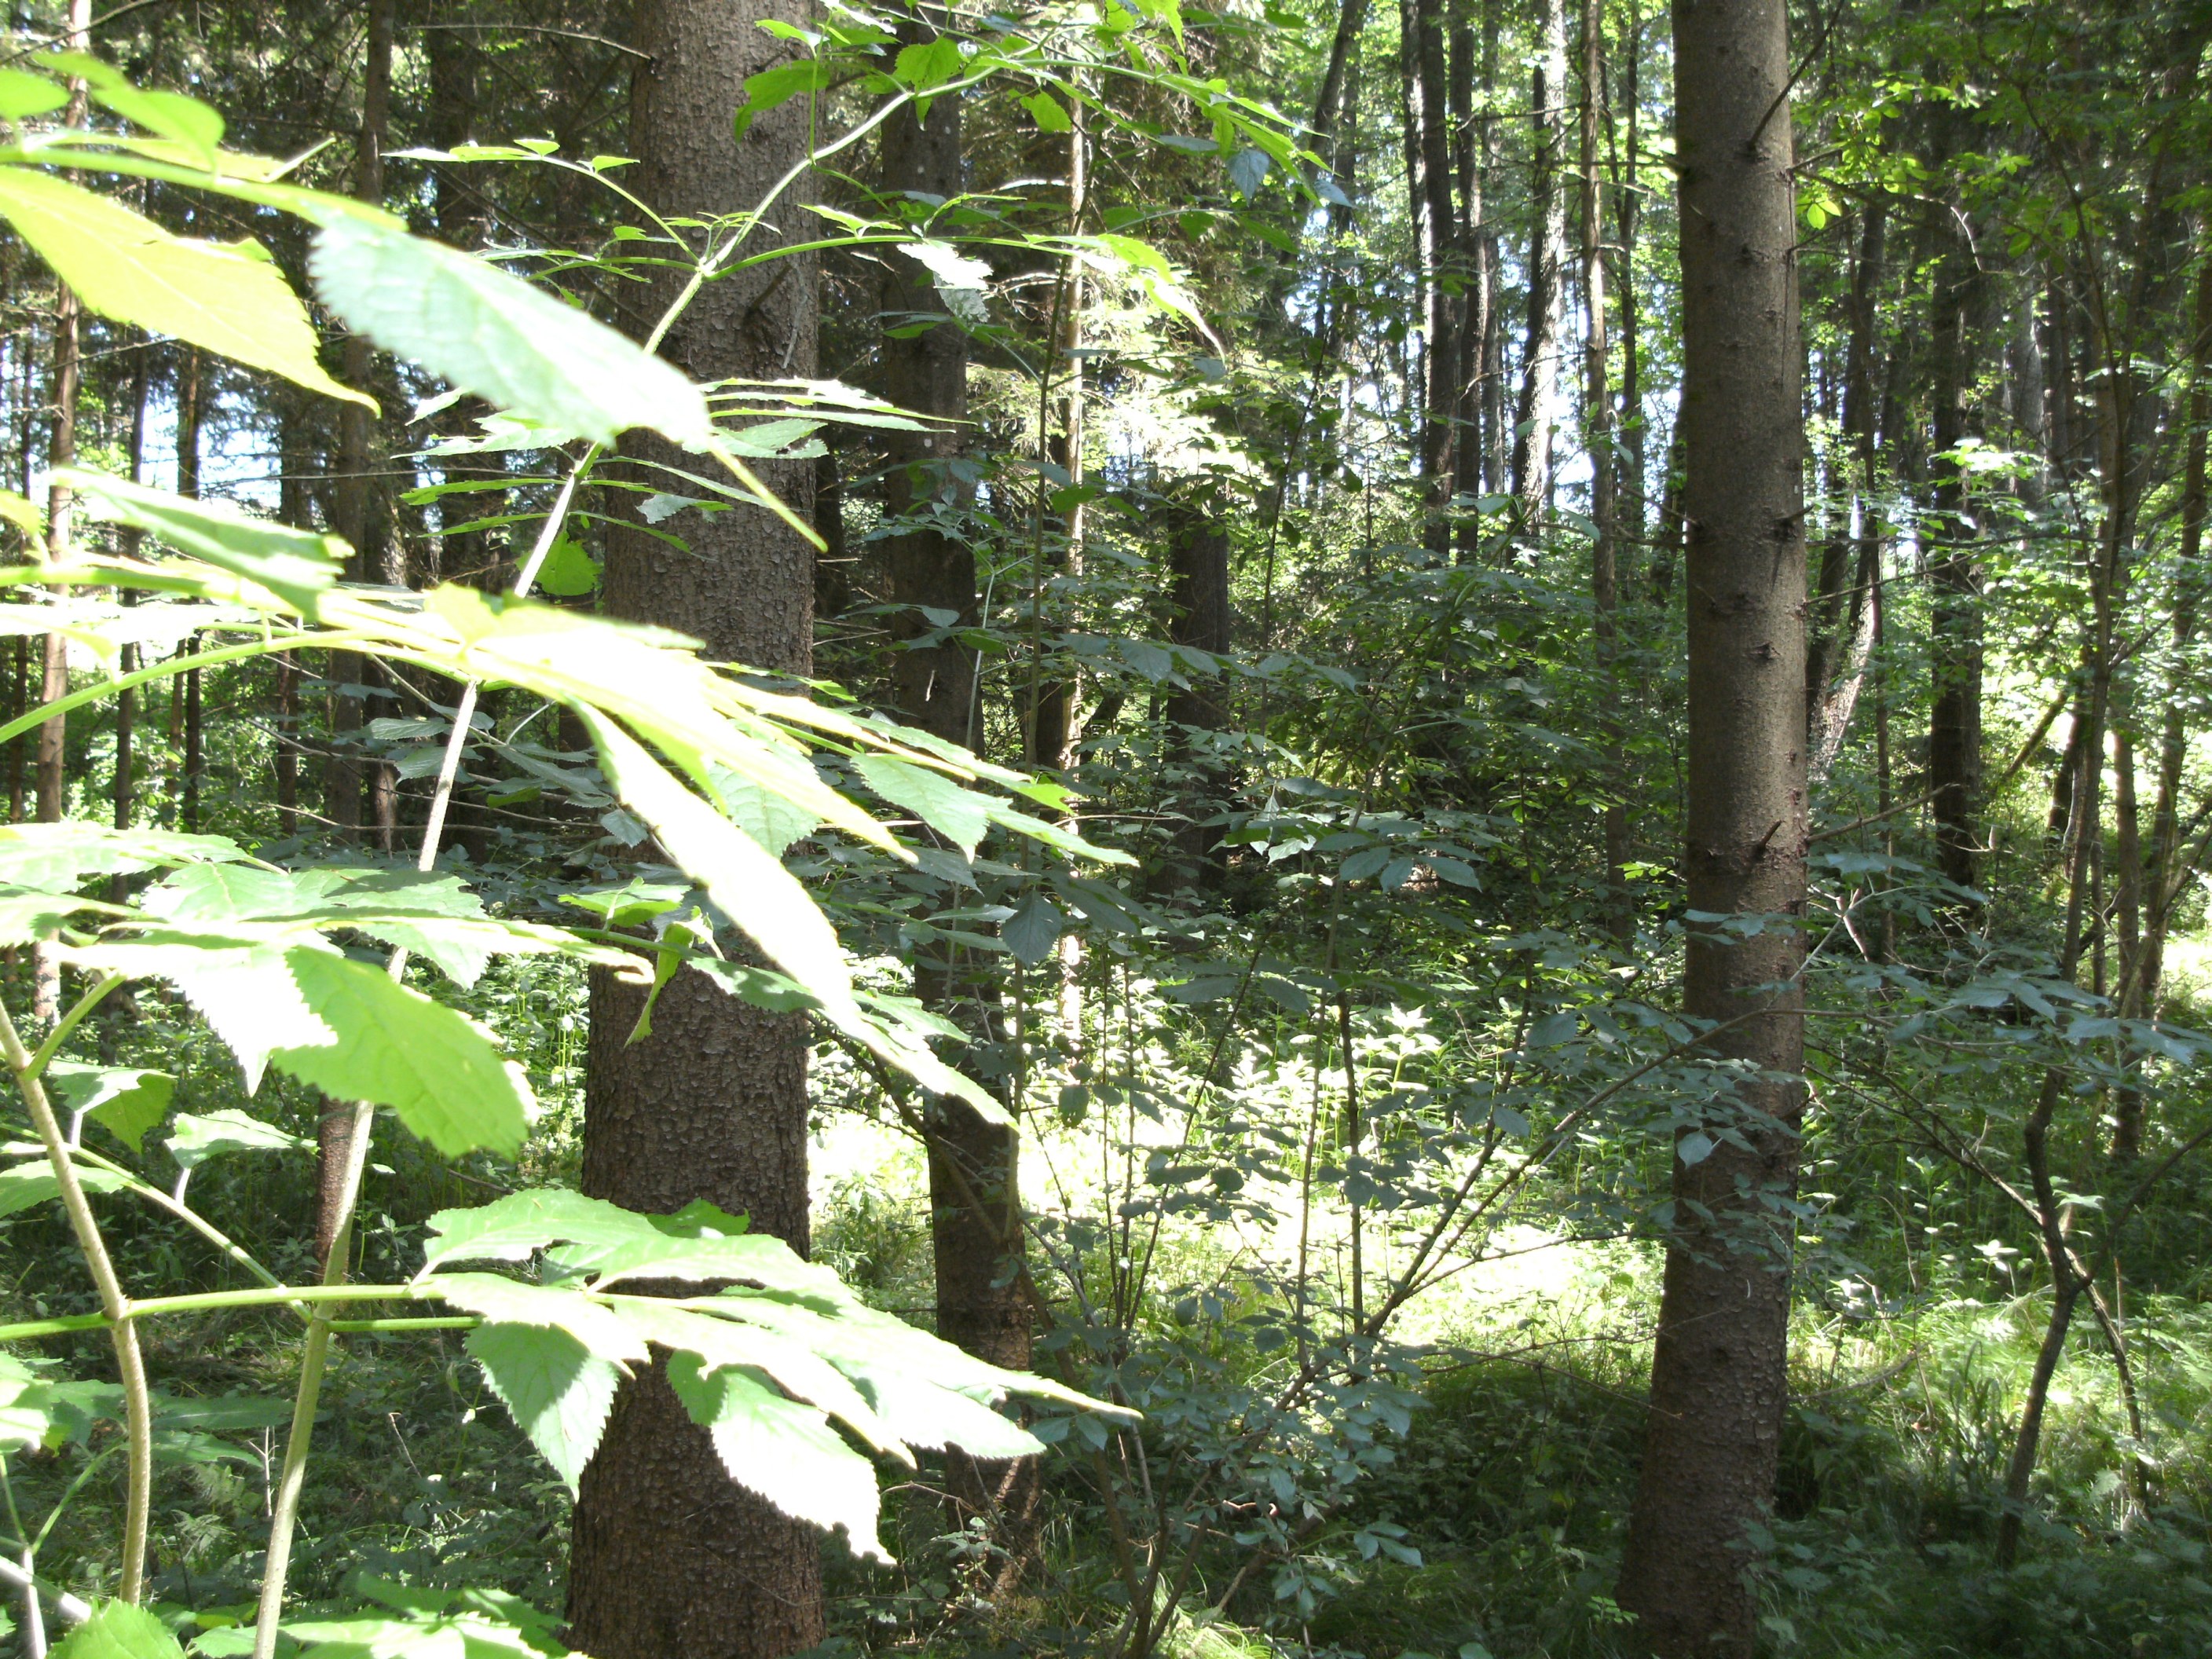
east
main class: Woodland
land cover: Spruce dominated mixed woodland
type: mire and swamp forests
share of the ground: > 75 %
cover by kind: coniferous forest trees 40 %, broadleaved forest trees 35 %, shrubs 15 %, herbaceous plants 10 %
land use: Forestry
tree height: > 5 m
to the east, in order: Tracks; Spruce dominated mixed woodland; Broadleaved woodland; Spruce dominated mixed woodland; Tracks; Grass margins; Triticale; Maize; Grass margins; Barley; Tracks; Grass margins; Maize
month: July
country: AT
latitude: 46.6887
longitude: 14.9277
